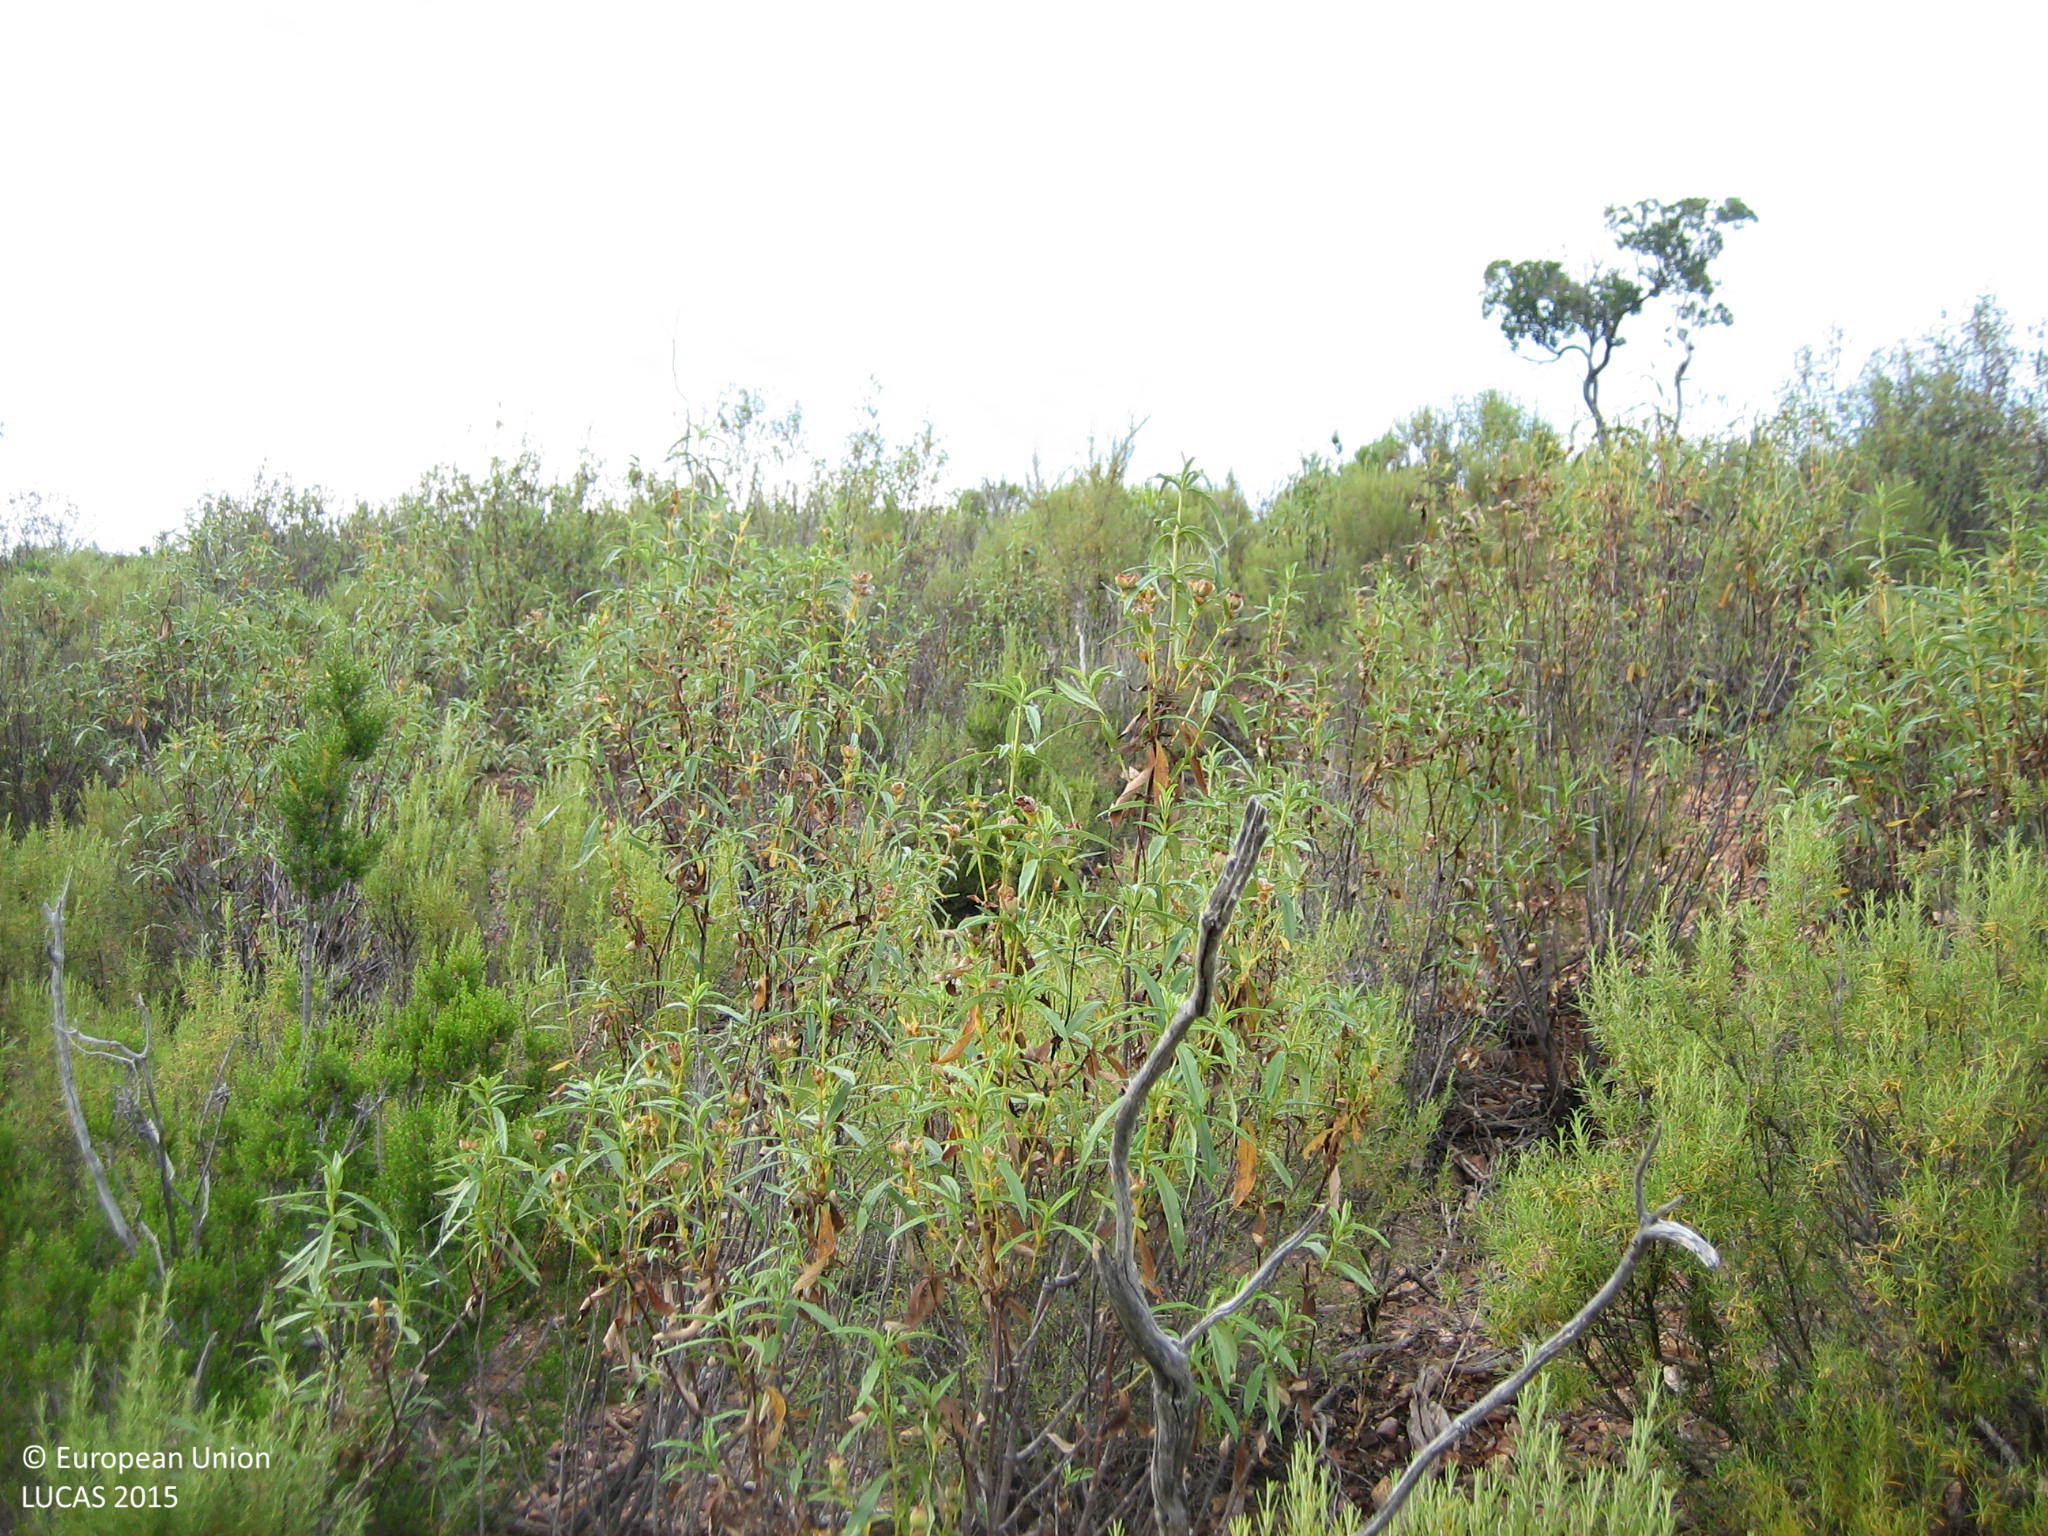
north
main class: Shrubland
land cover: Shrubland with sparse tree cover
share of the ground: > 75 %
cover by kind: shrubs 90 %, broadleaved forest trees 5 %, herbaceous plants 5 %
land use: Semi-natural and natural areas not in use
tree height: > 5 m
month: June
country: ES
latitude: 39.1294
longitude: -4.7364
